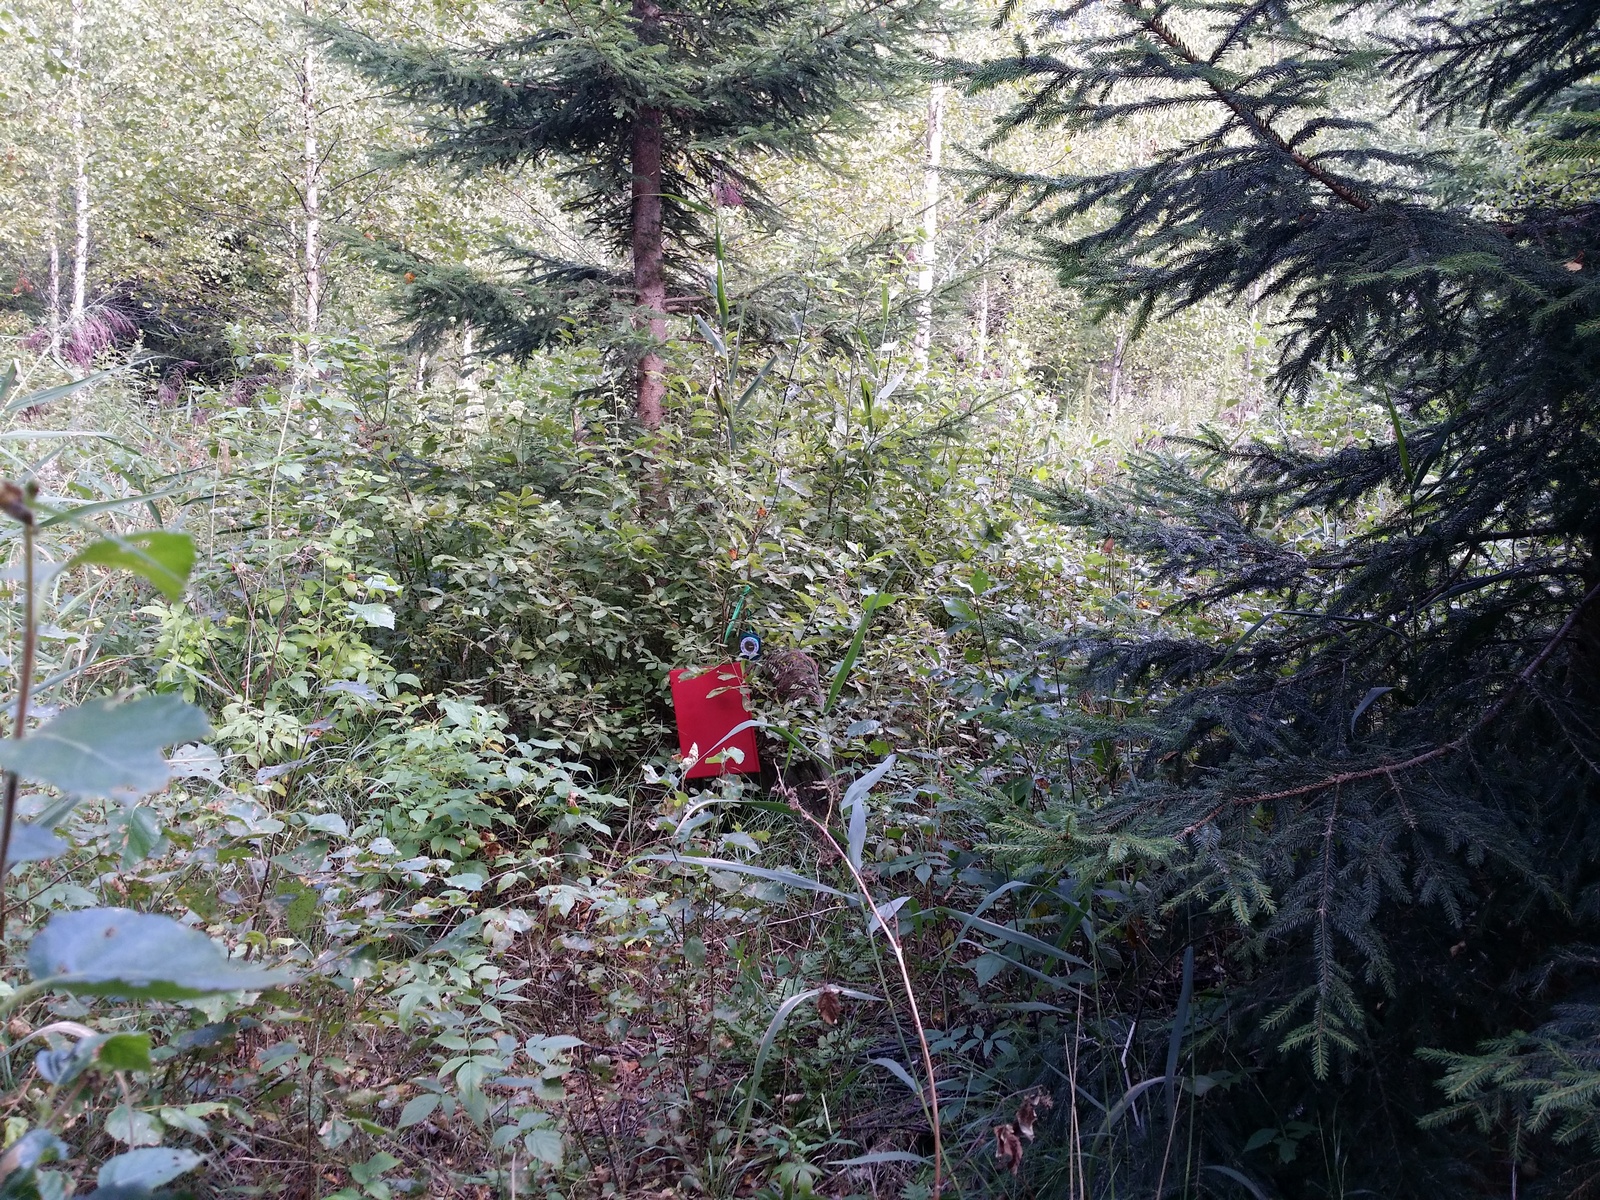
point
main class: Woodland
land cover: Broadleaved woodland
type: non-riverine alder, birch or aspen forest
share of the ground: > 75 %
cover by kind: broadleaved forest trees 75 %, shrubs 15 %, coniferous forest trees 10 %
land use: Forestry
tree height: > 5 m
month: August
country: LV
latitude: 57.2989
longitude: 27.6216
